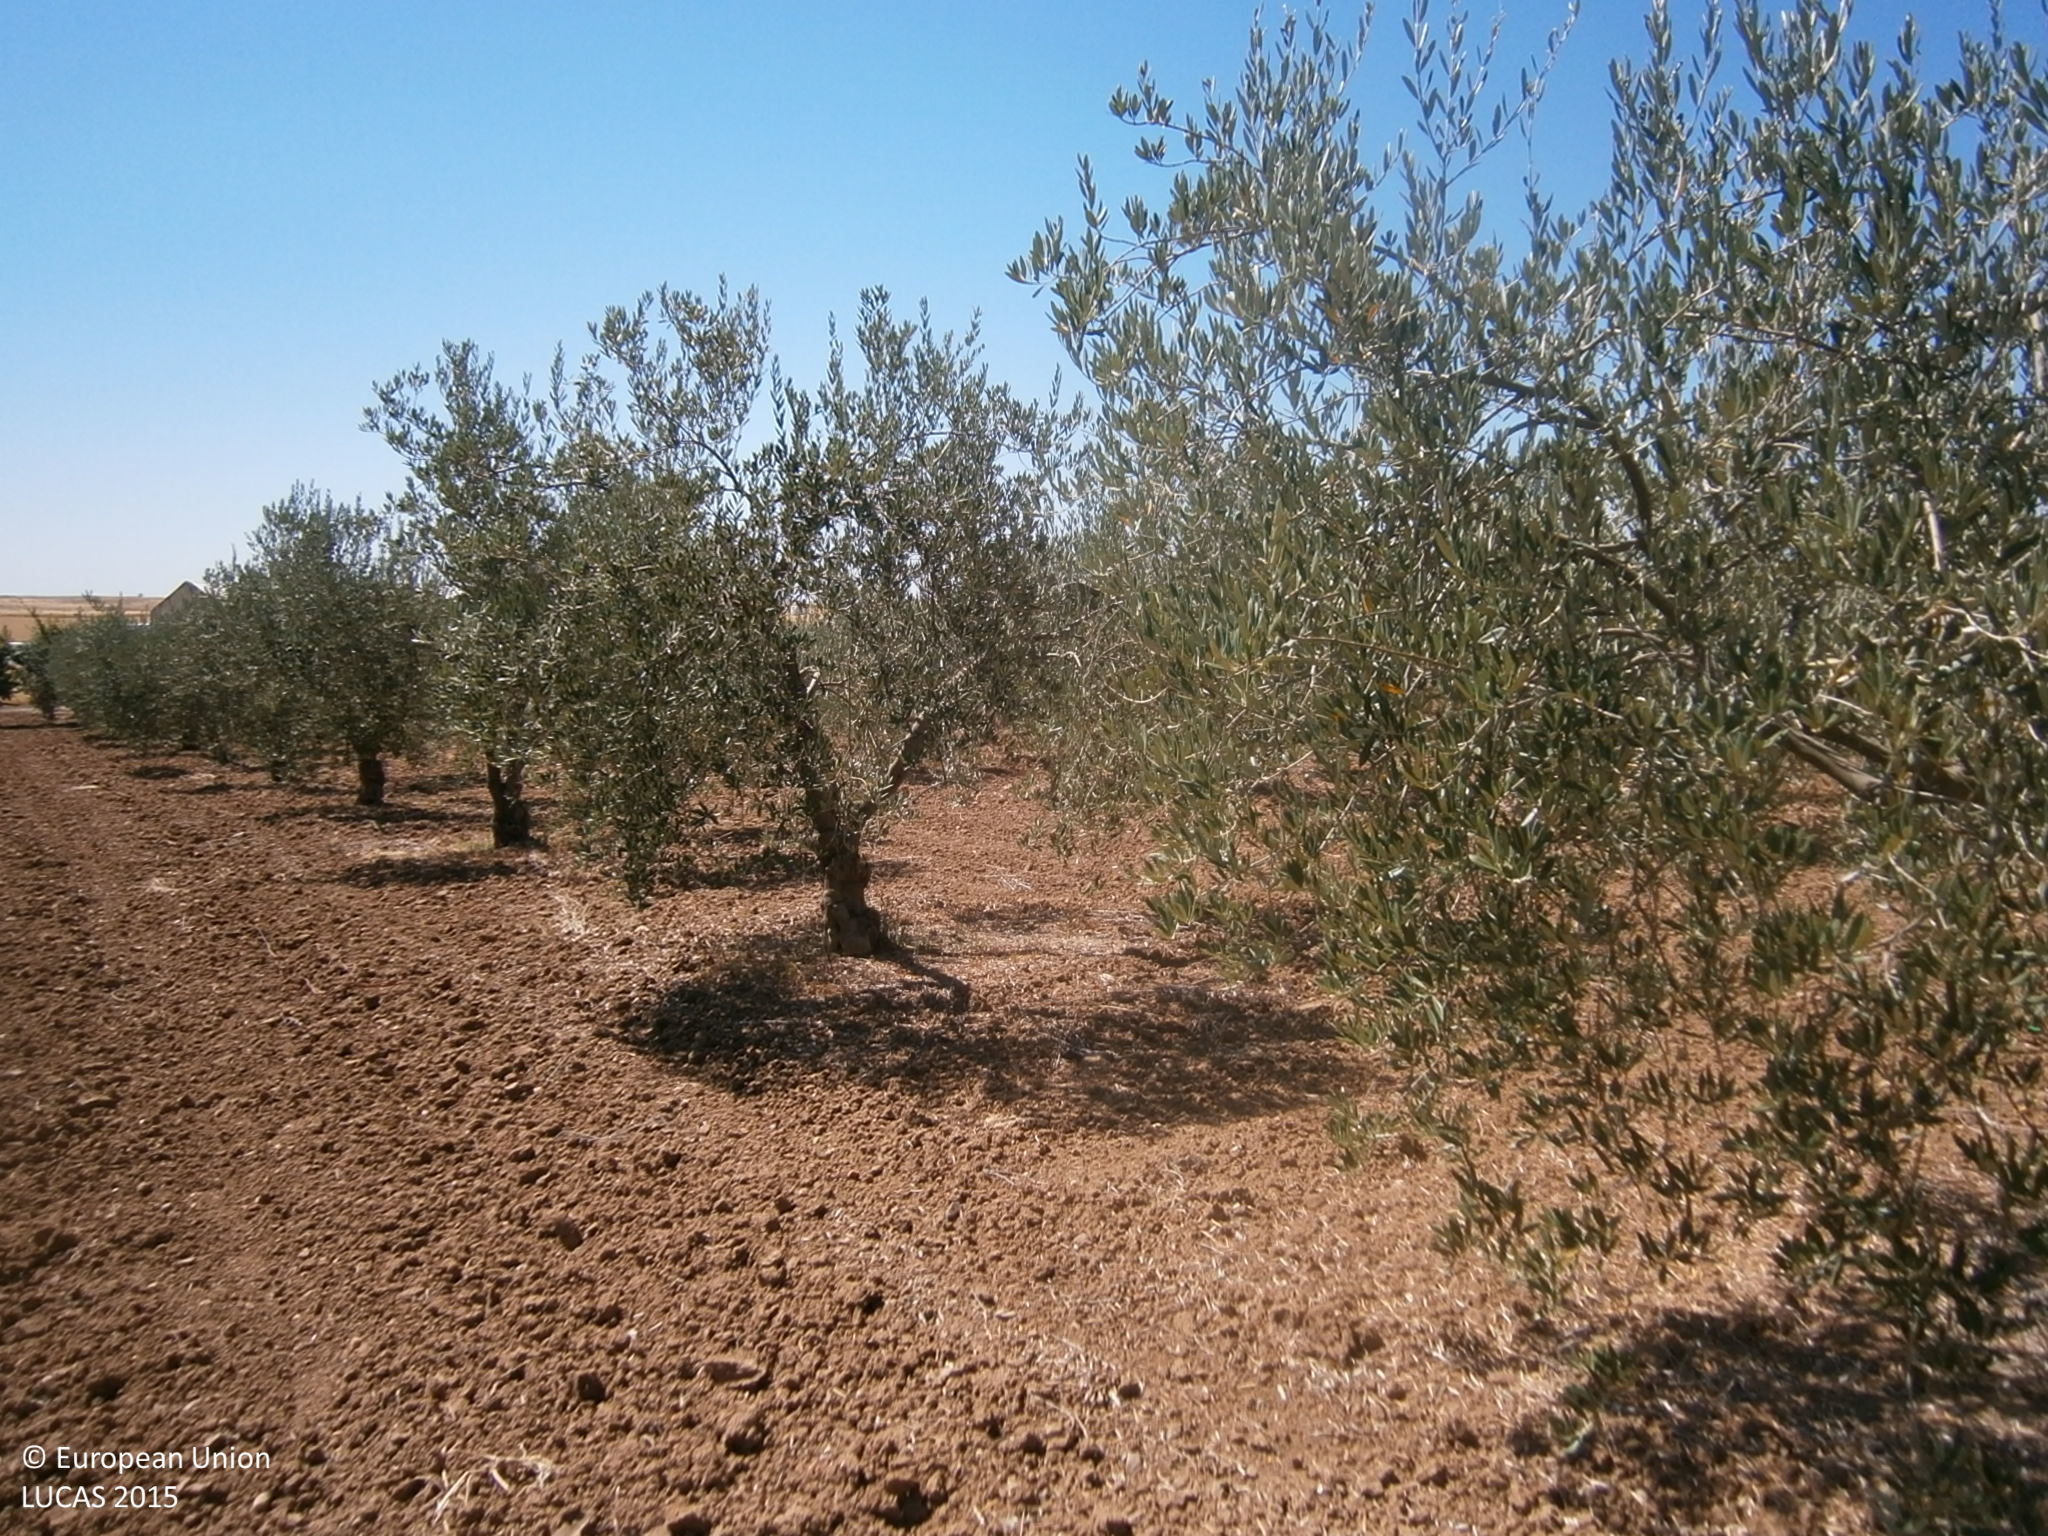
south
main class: Cropland
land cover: Olive groves
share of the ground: 25 - 50 %
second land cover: Other bare soil
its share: > 75 %
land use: Agriculture (excluding fallow land and kitchen gardens)
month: July
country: ES
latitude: 38.9165
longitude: -7.0137
